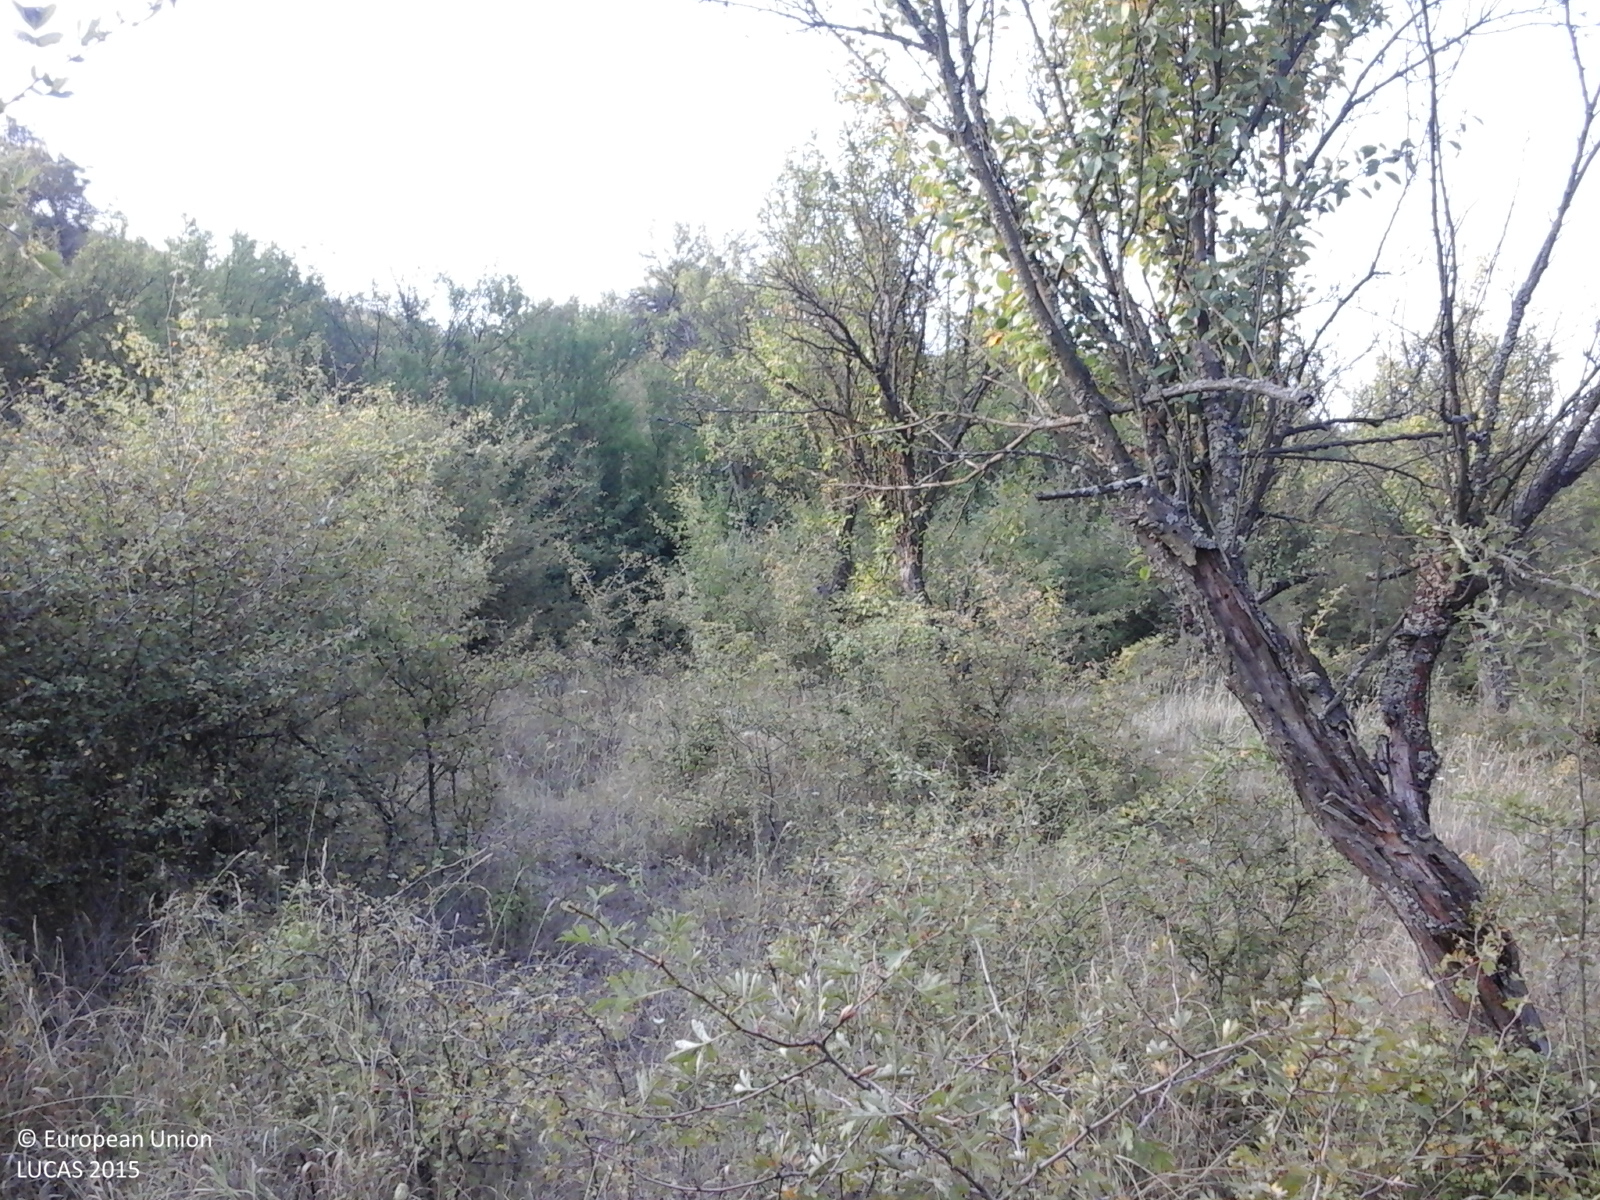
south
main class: Cropland
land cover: Apple fruit
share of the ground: > 75 %
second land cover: Spontaneously vegetated surfaces
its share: > 75 %
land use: Agriculture (excluding fallow land and kitchen gardens)
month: August
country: RO
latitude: 44.4421
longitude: 23.5607
